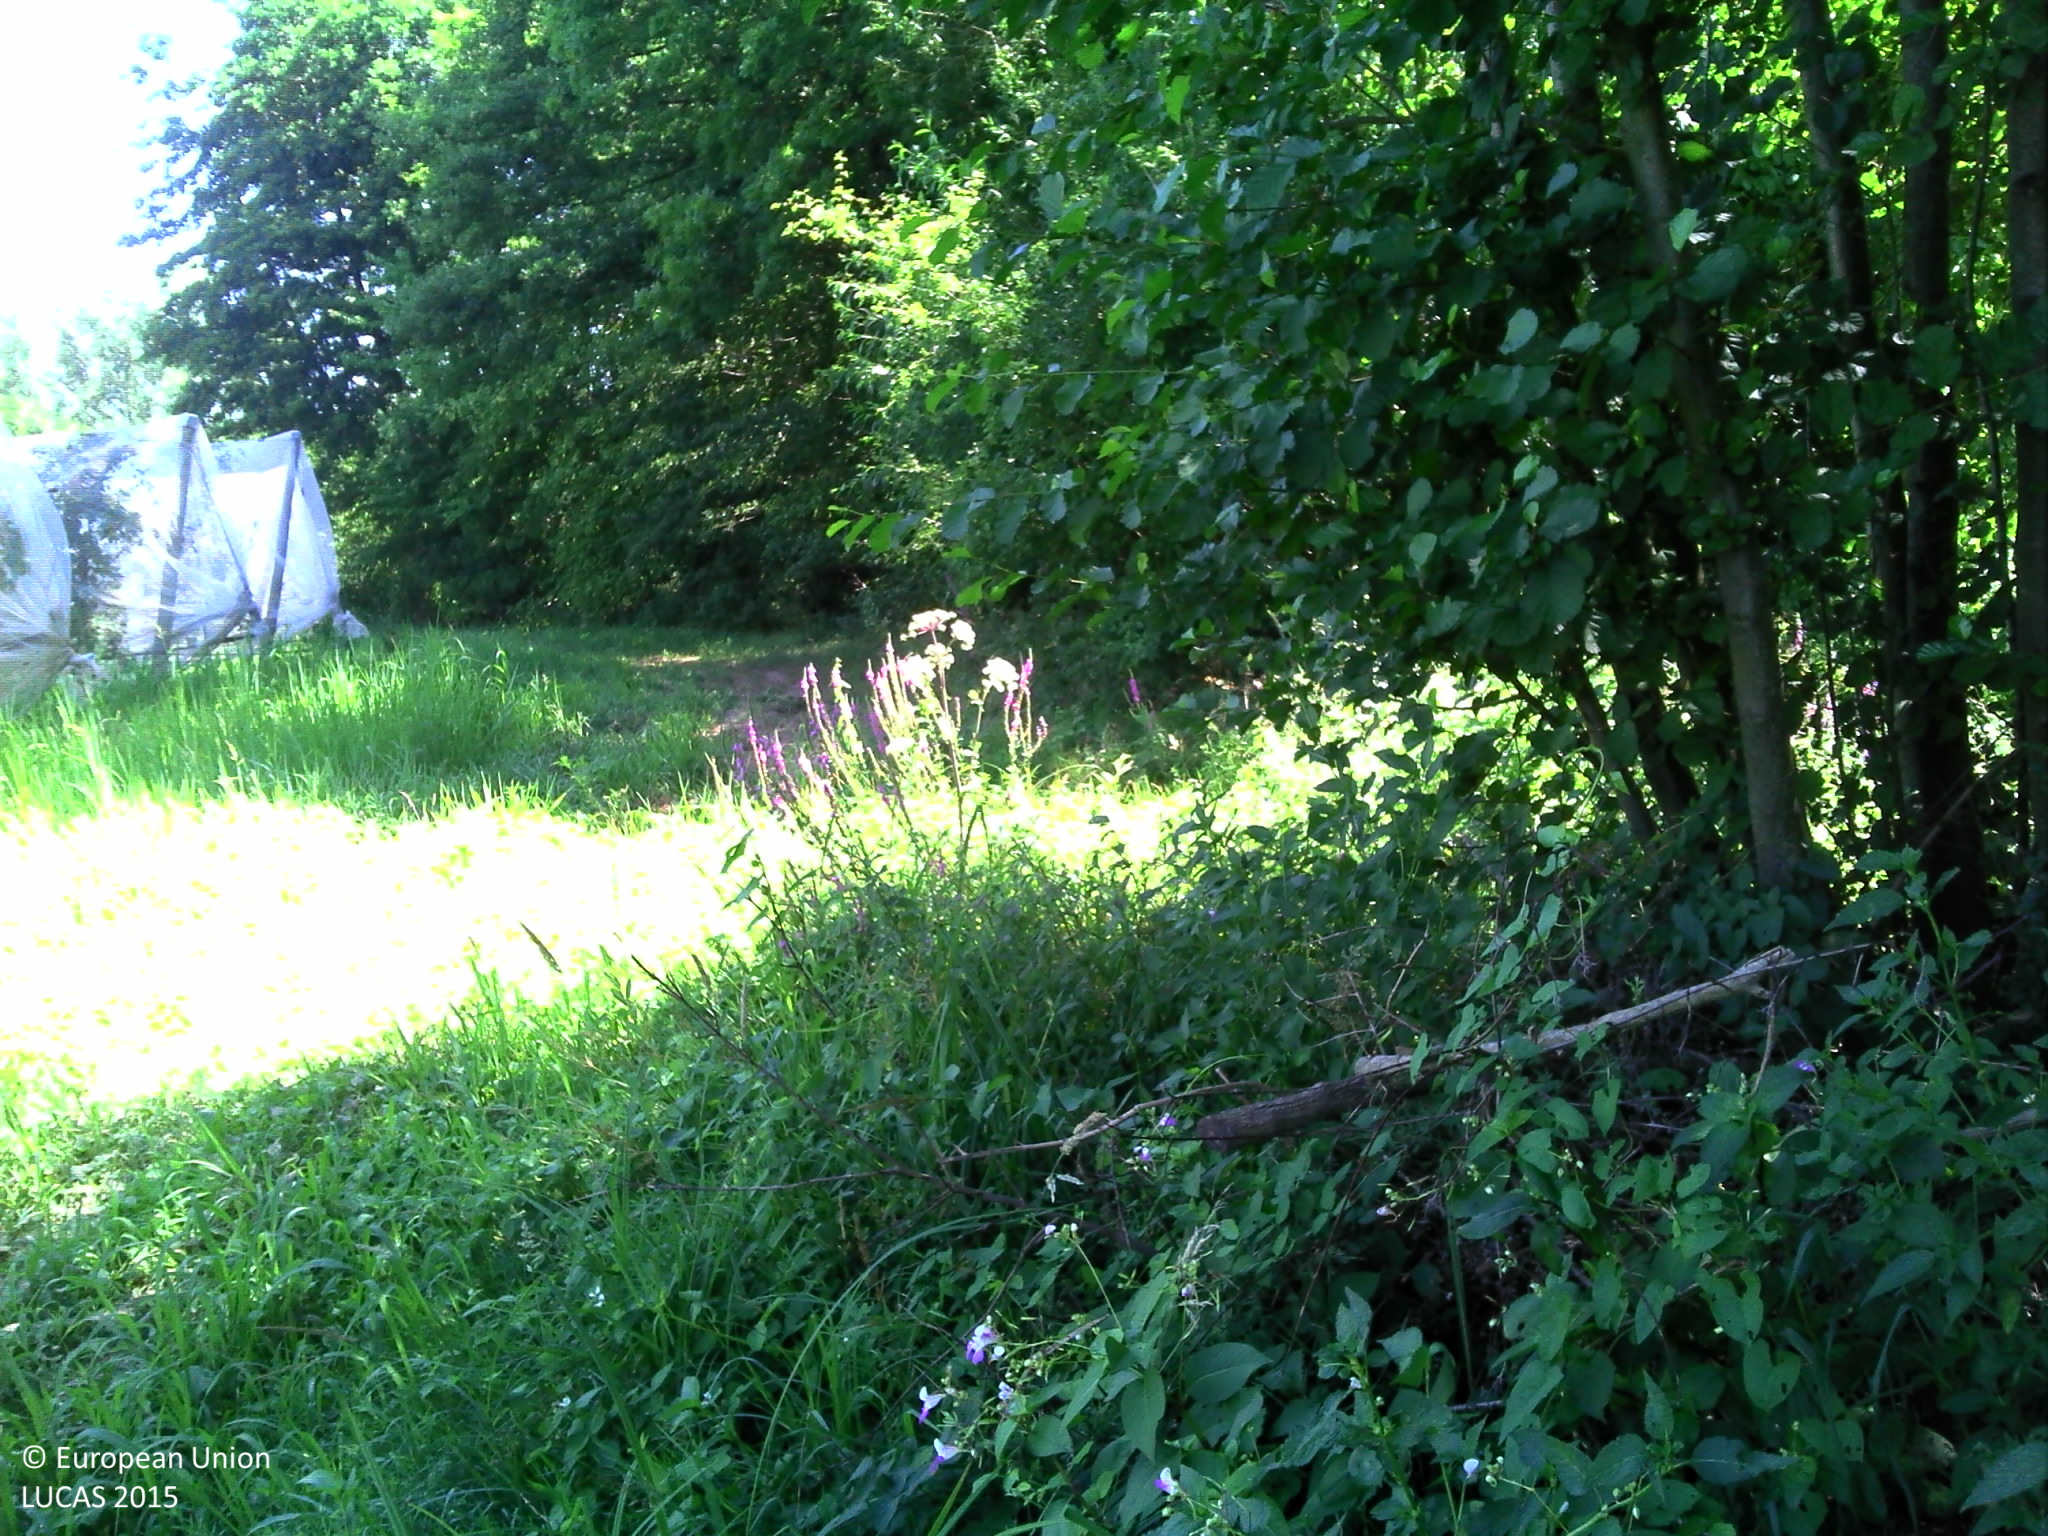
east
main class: Woodland
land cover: Broadleaved woodland
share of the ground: > 75 %
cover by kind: broadleaved forest trees 80 %, herbaceous plants 20 %
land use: Semi-natural and natural areas not in use
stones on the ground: < 10 %
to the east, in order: Broadleaved woodland; Rivers and streams; Broadleaved woodland; Rivers and streams; Broadleaved woodland; Maize; Apple fruit
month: July
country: FR
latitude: 45.3265
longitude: 4.8885
